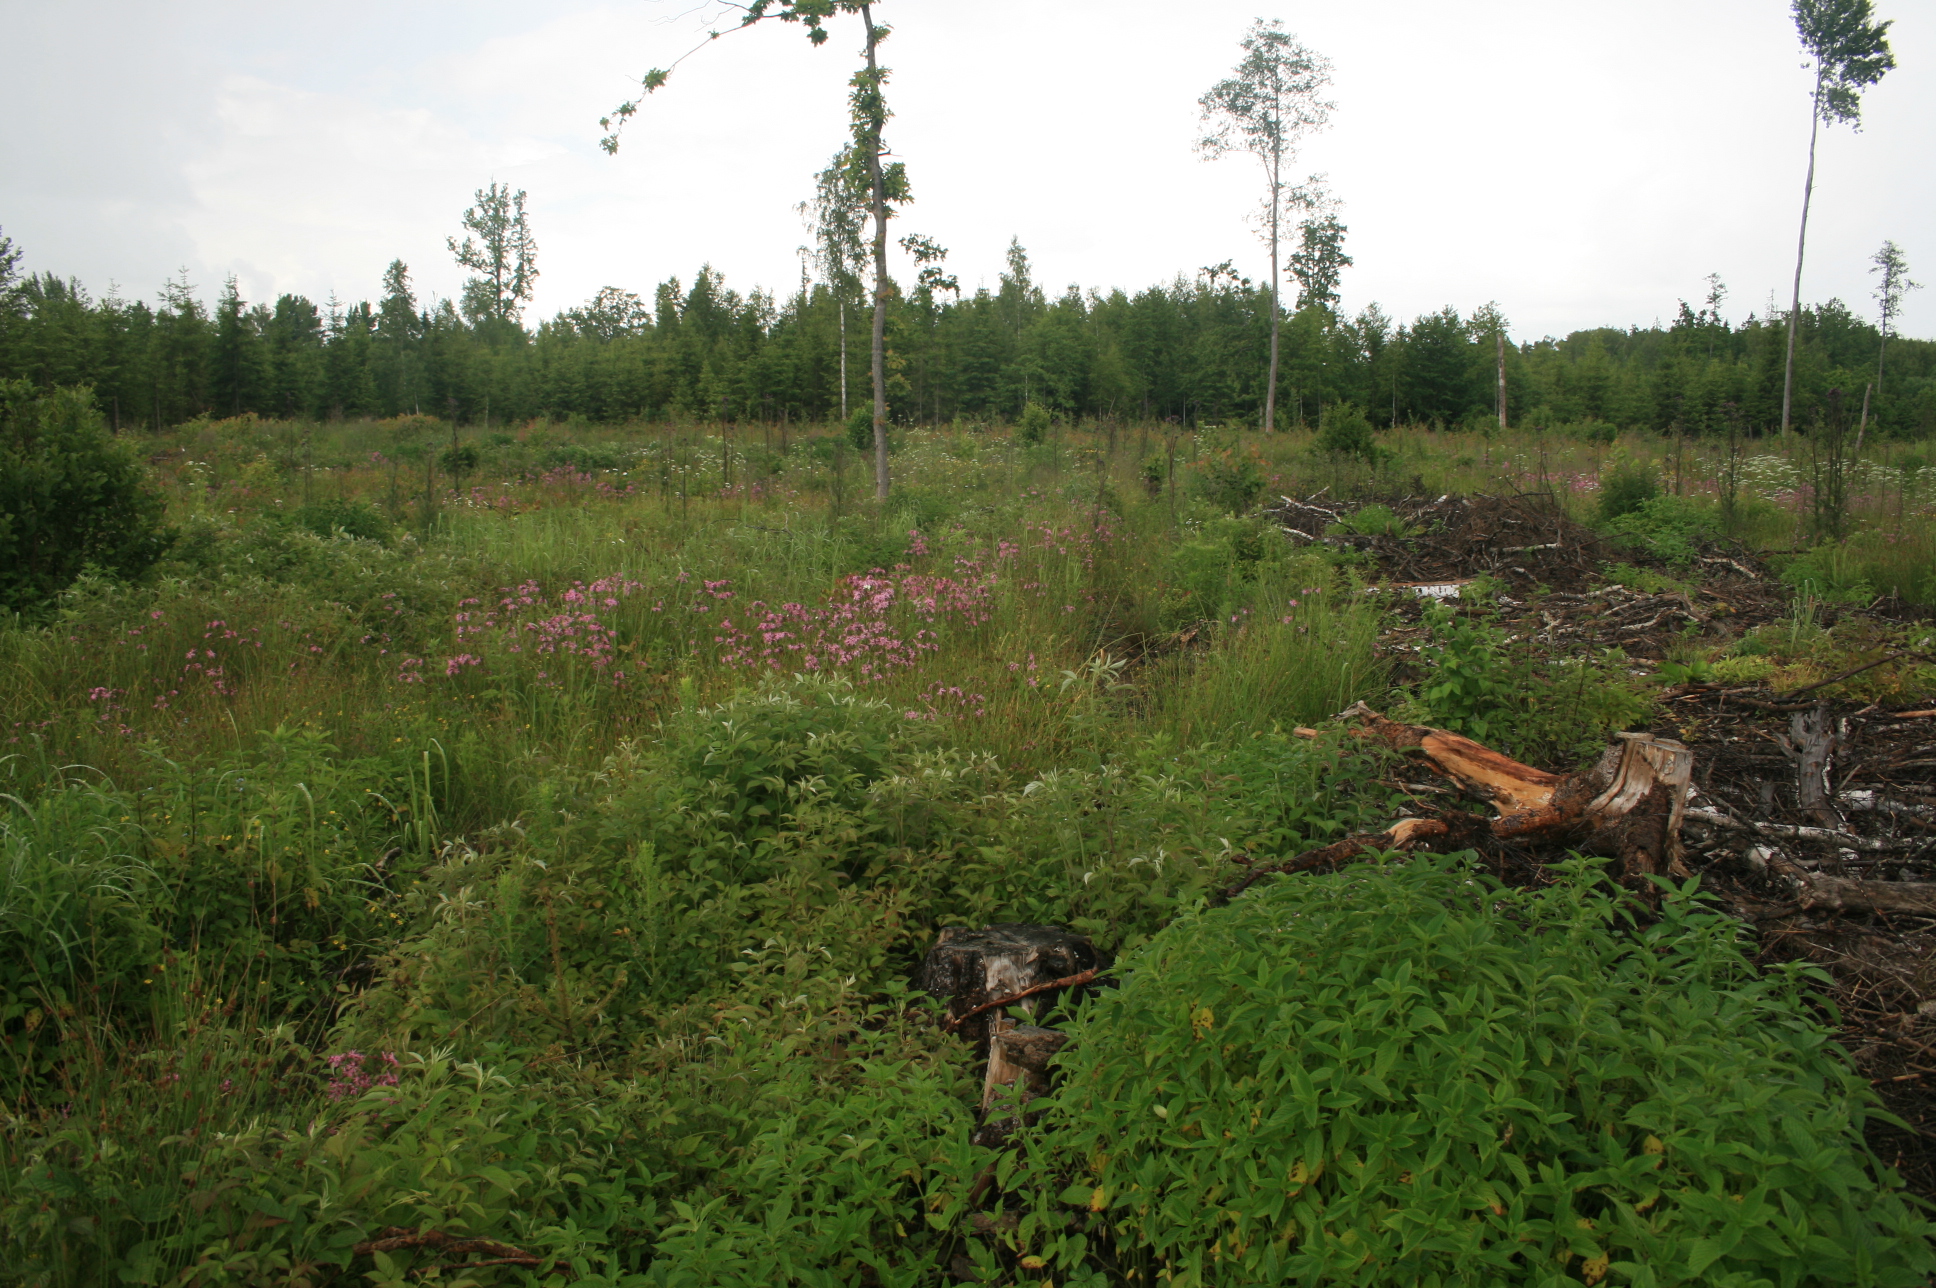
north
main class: Shrubland
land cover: Shrubland with sparse tree cover
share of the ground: > 75 %
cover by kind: shrubs 65 %, herbaceous plants 30 %, broadleaved forest trees 5 %
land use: Forestry
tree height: < 5 m
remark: Clear cut
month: June
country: LT
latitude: 55.3440
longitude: 22.0541
